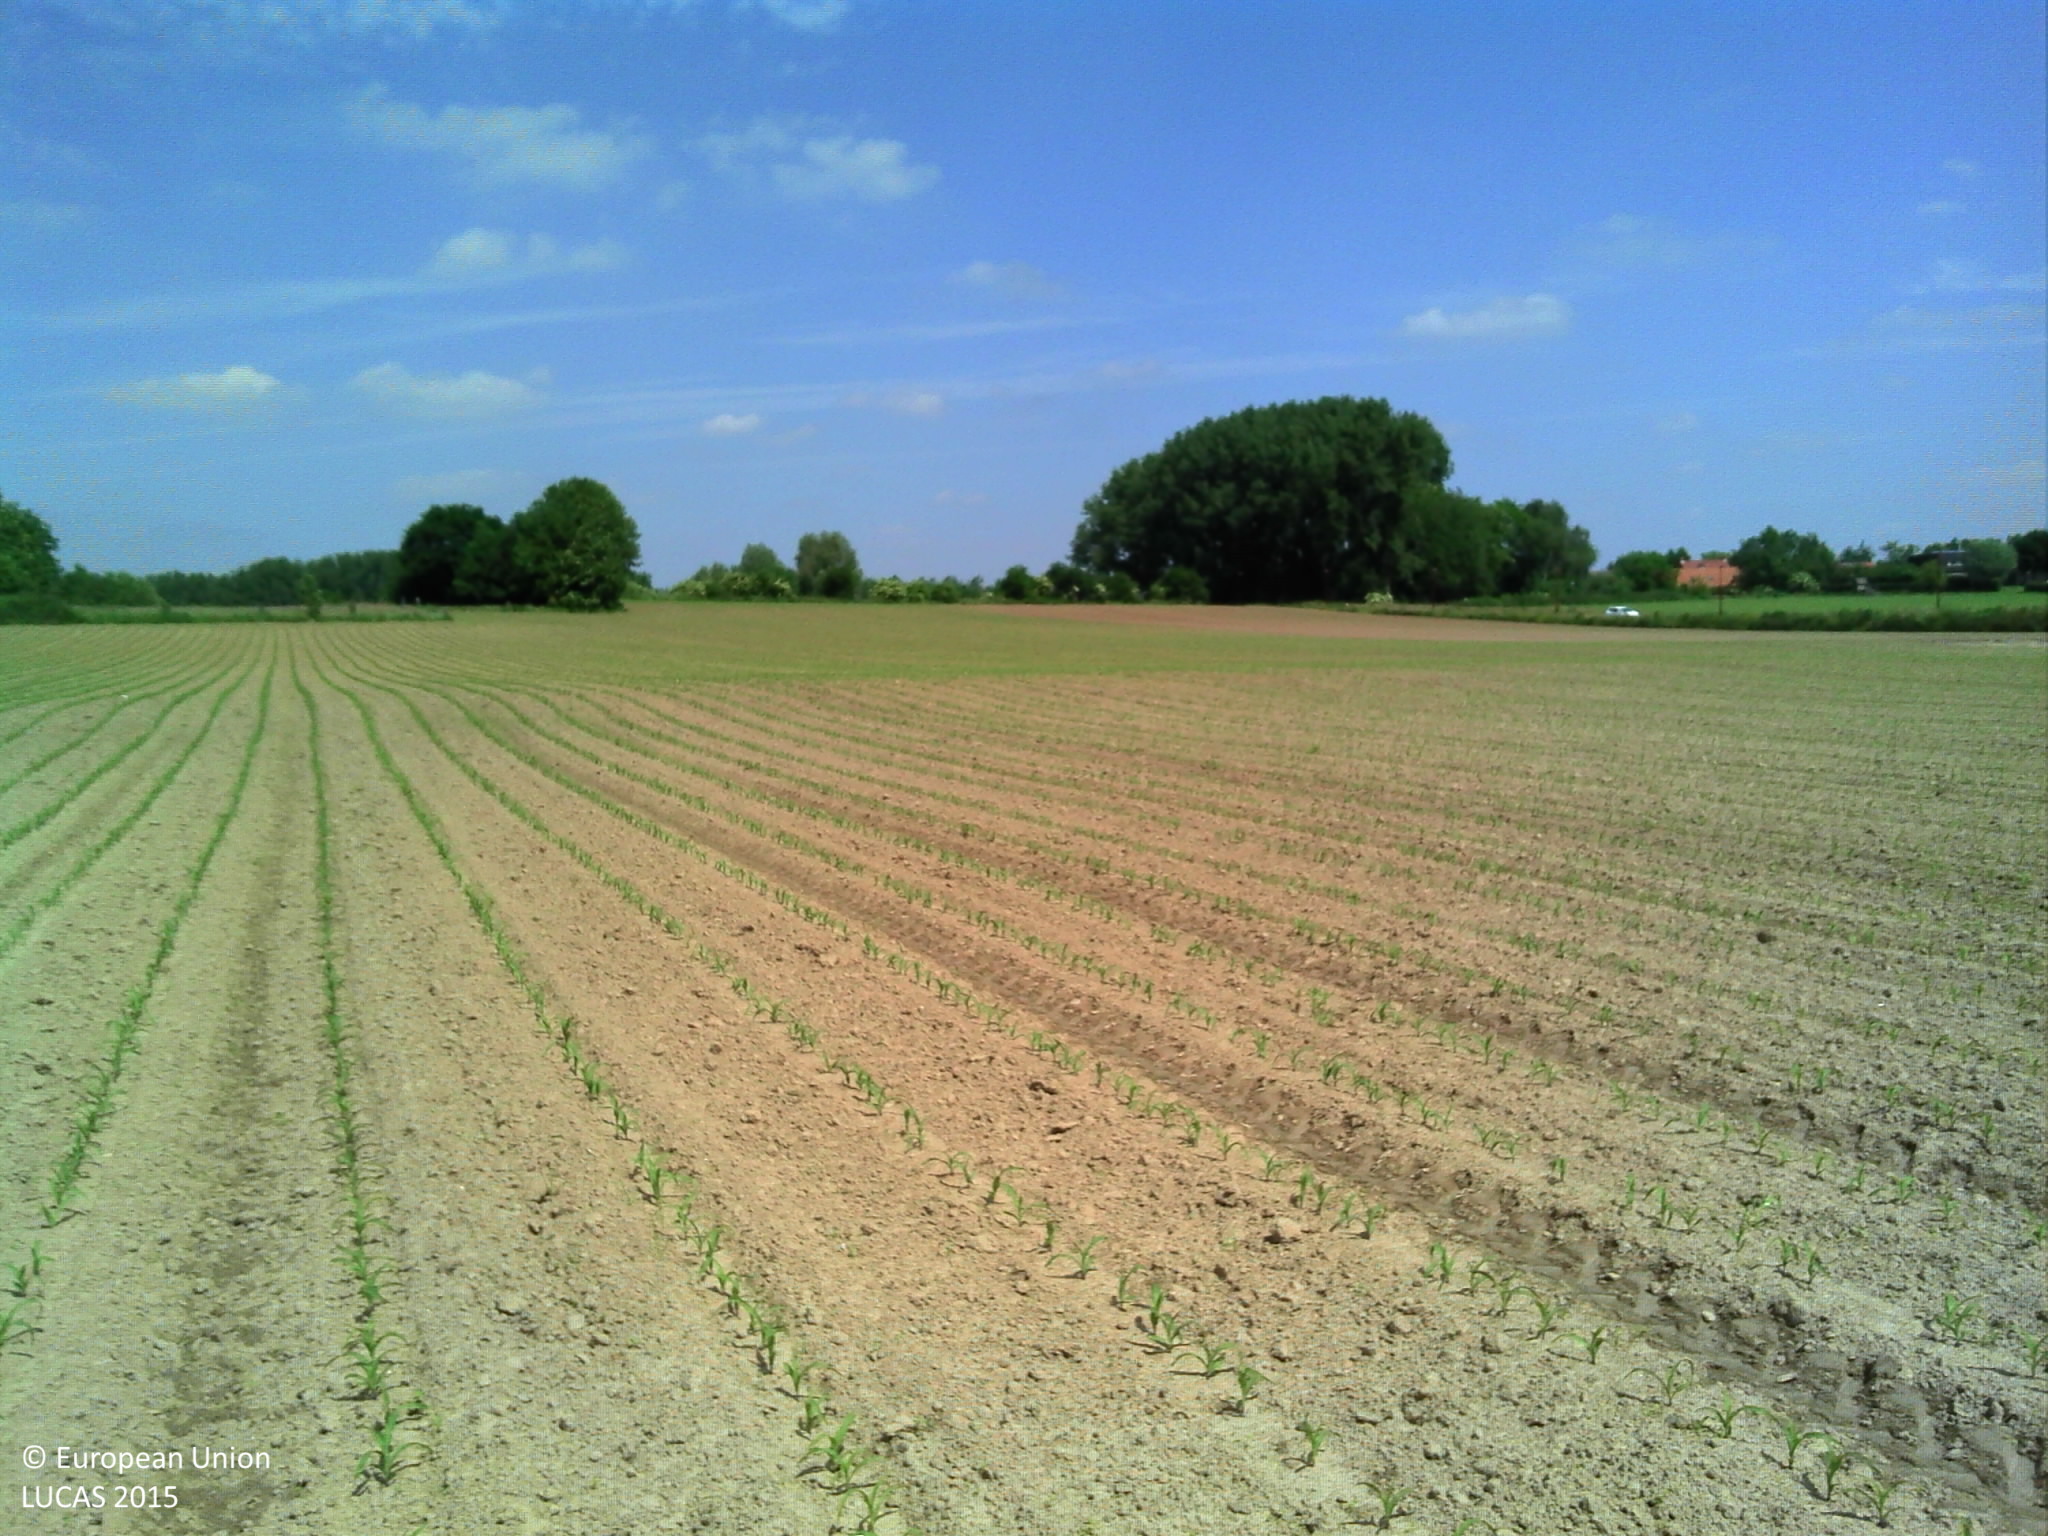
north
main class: Cropland
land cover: Maize
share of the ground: < 10 %
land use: Agriculture (excluding fallow land and kitchen gardens)
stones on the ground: < 10 %
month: June
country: BE
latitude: 50.9370
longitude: 3.8318
